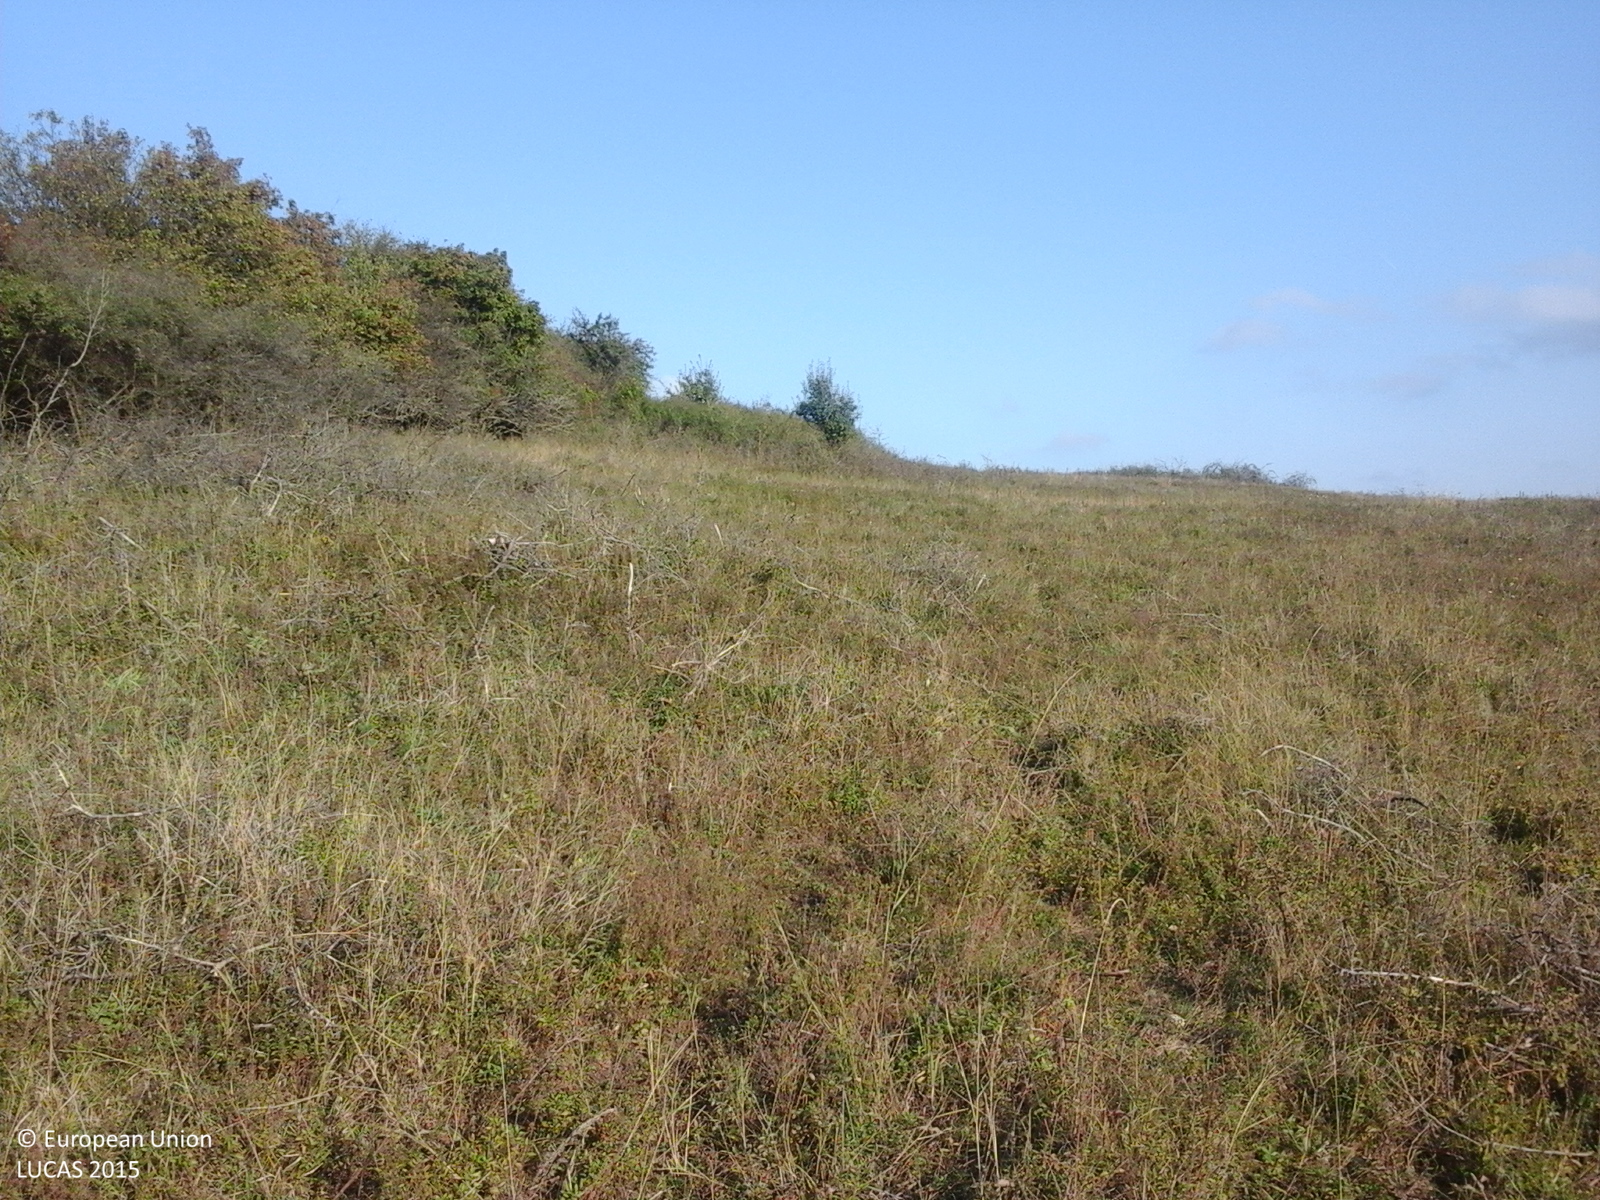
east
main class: Grassland
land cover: Grassland with sparse tree/shrub cover
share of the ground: > 75 %
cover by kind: herbaceous plants 95 %, broadleaved forest trees 5 %
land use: Agriculture (excluding fallow land and kitchen gardens)
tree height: < 5 m
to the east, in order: Grassland with sparse tree/shrub cover; Shrubland without tree cover; Grassland with sparse tree/shrub cover; Tracks; Grassland with sparse tree/shrub cover; Grassland without tree/shrub cover
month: October
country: RO
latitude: 46.3614
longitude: 24.1020
